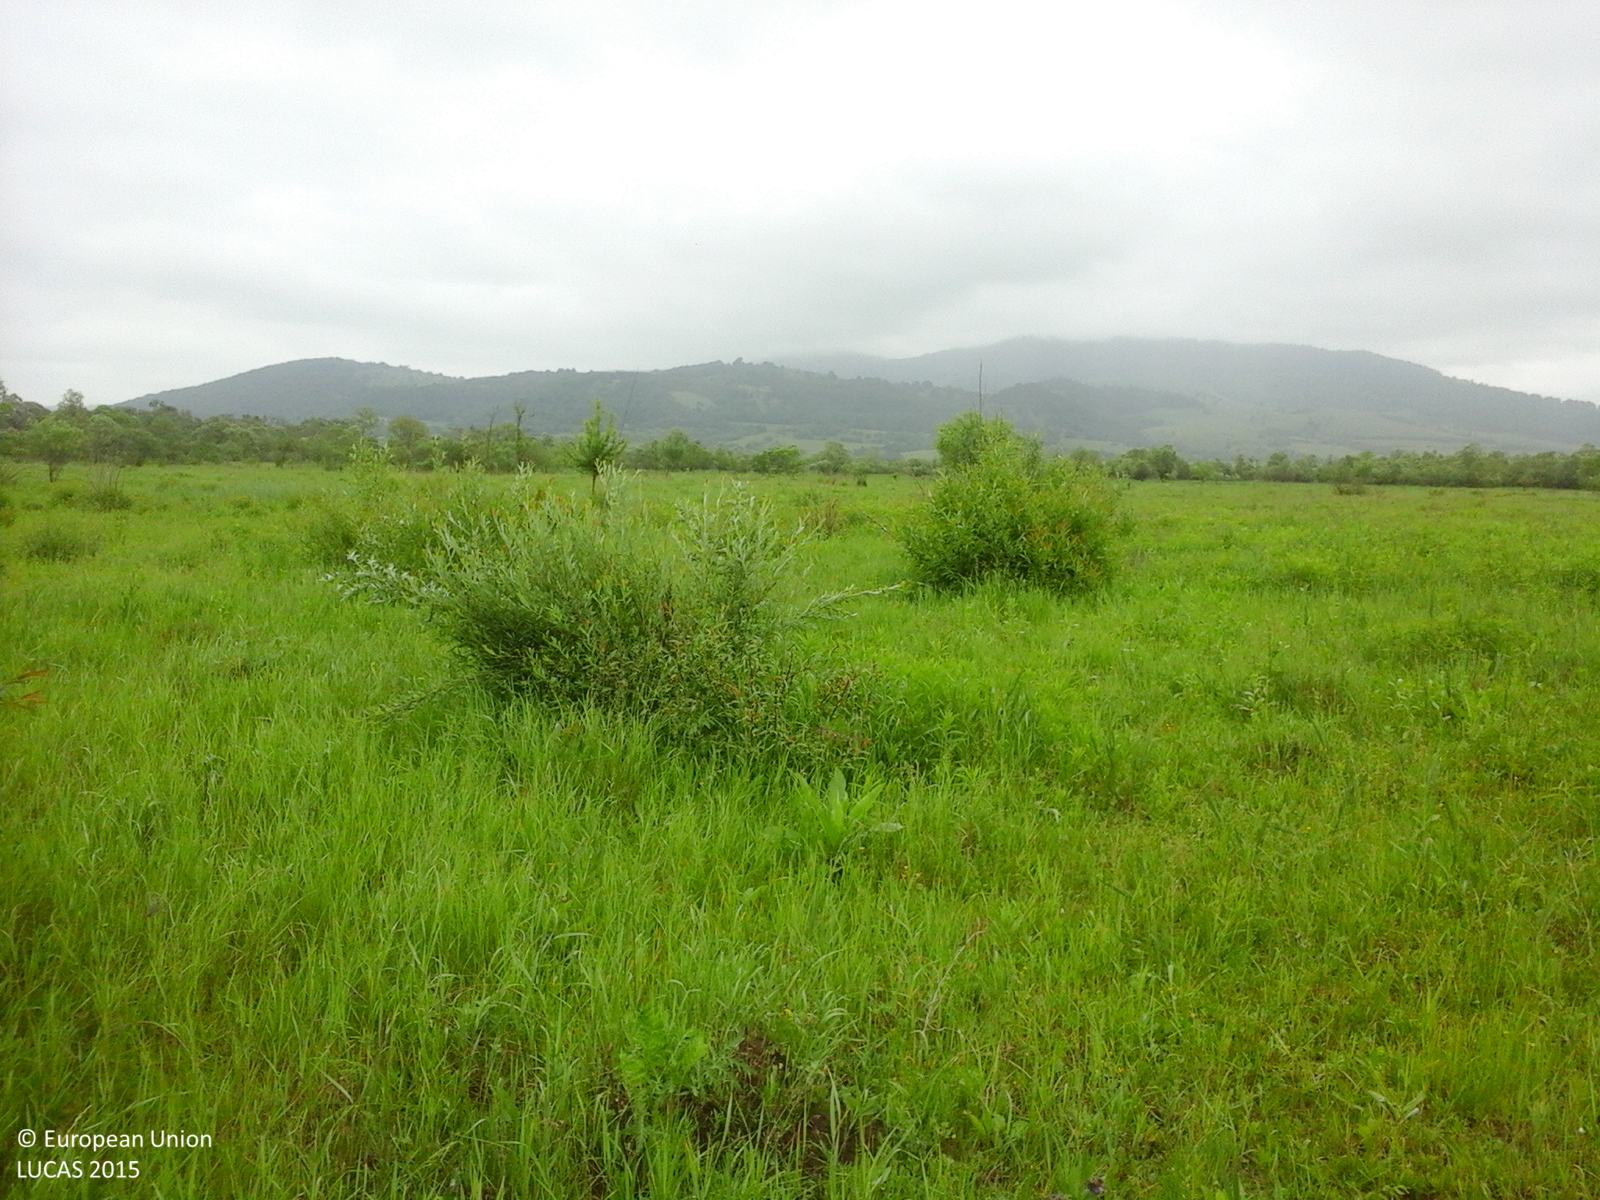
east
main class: Shrubland
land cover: Shrubland with sparse tree cover
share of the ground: > 75 %
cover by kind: herbaceous plants 85 %, shrubs 10 %, broadleaved forest trees 5 %
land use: Agriculture (excluding fallow land and kitchen gardens)
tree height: < 5 m
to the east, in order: Shrubland with sparse tree cover
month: May
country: RO
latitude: 45.9309
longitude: 25.2256
